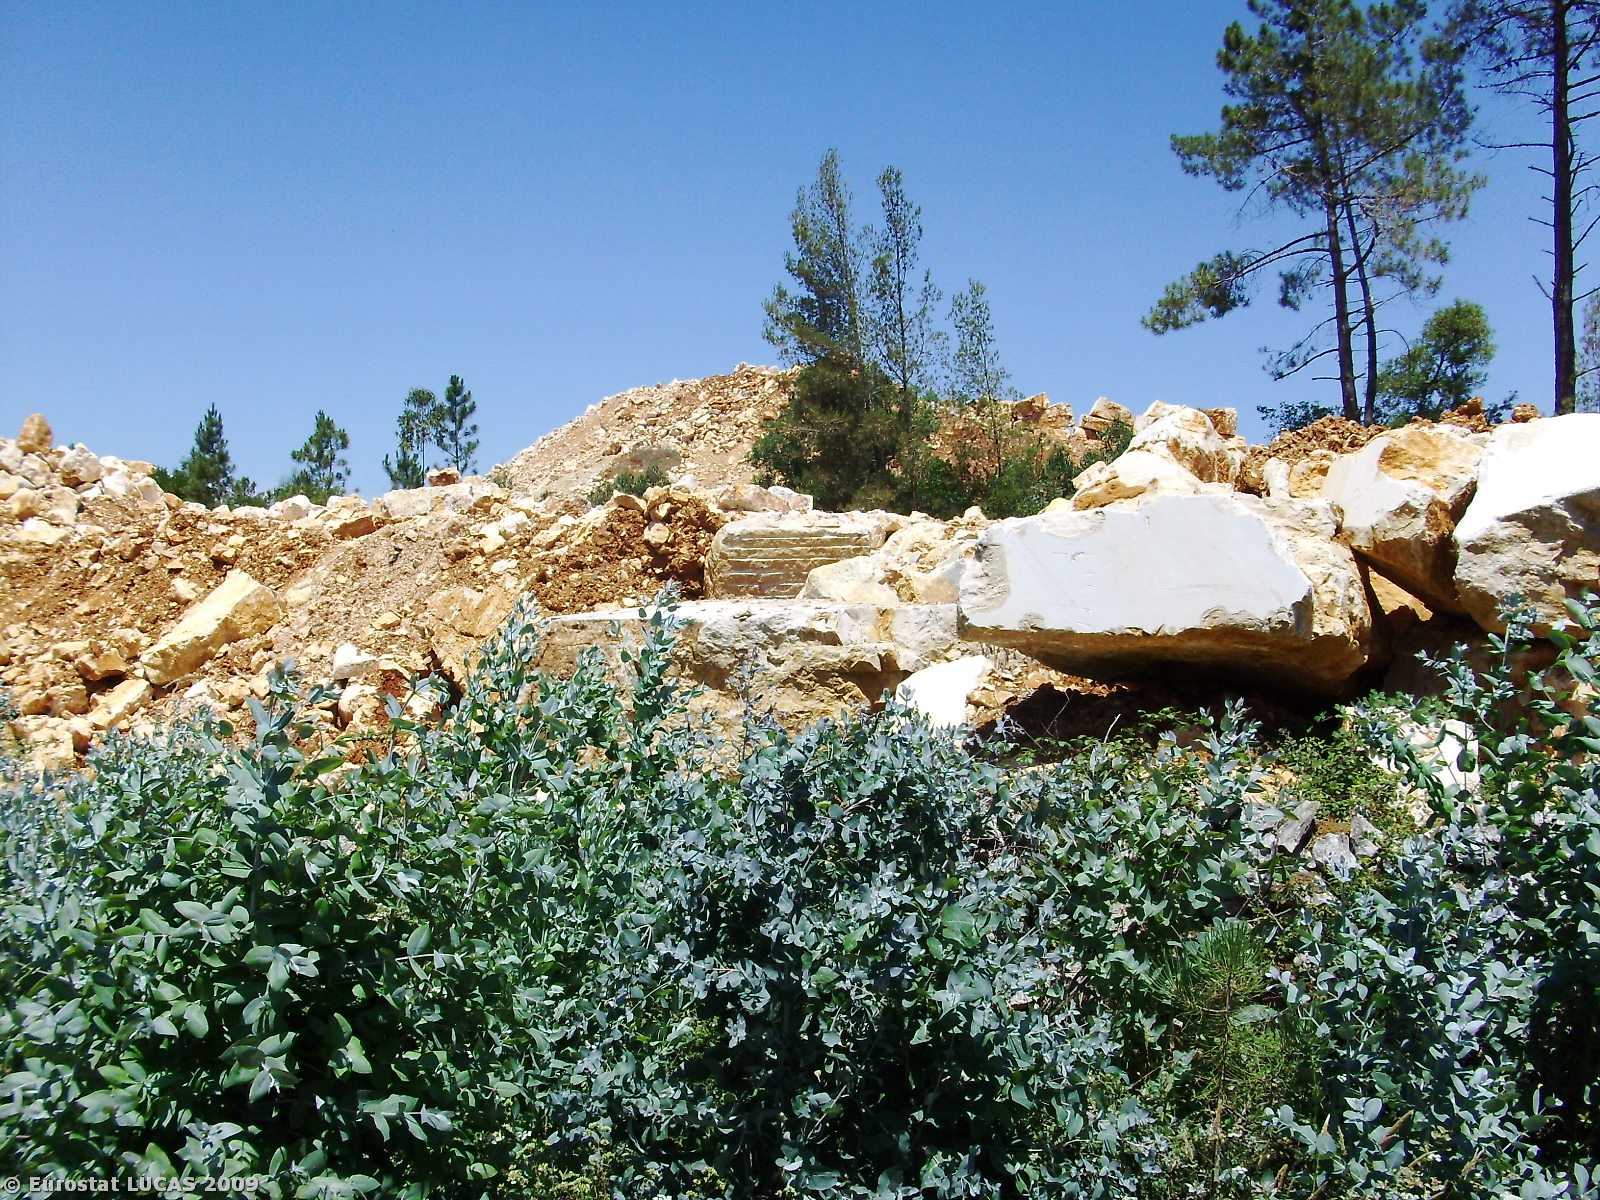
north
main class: Woodland
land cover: Broadleaved woodland
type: plantations and self-sown exotic forest
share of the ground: 50 - 75 %
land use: Forestry
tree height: > 5 m
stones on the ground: > 50 %
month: July
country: PT
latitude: 39.5586
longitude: -8.9049
